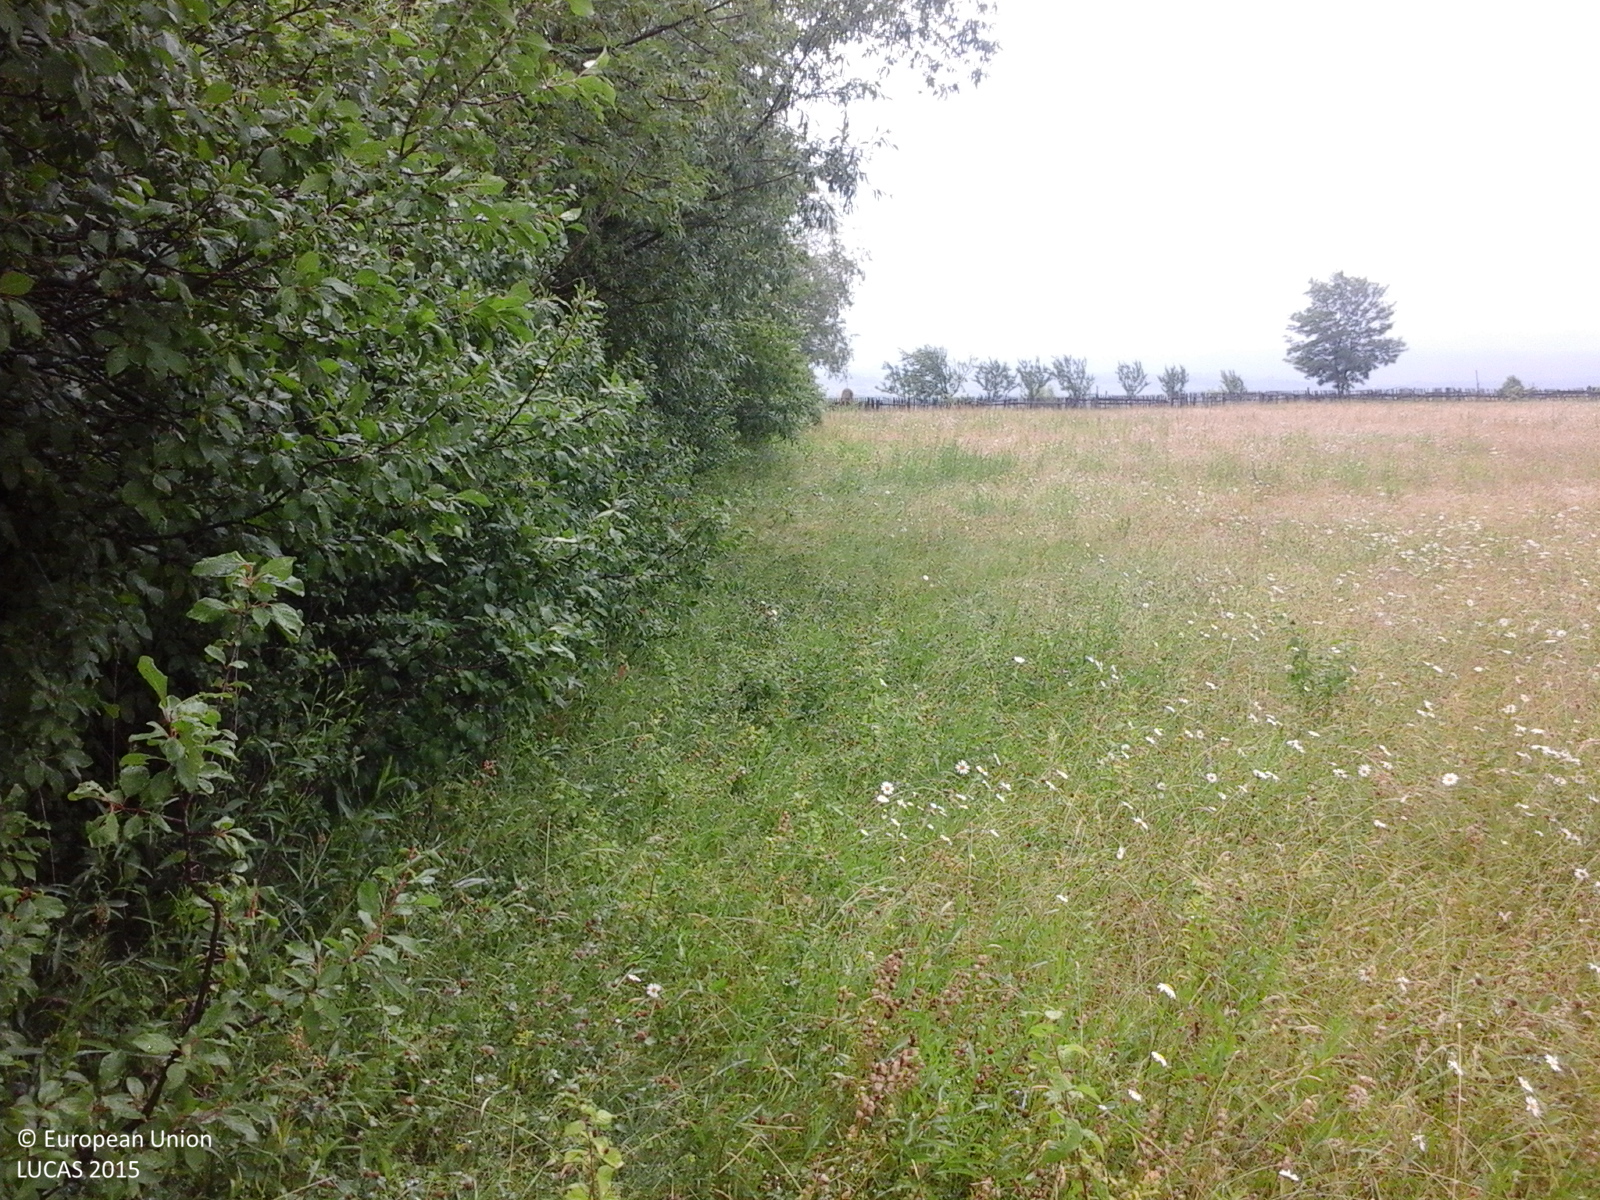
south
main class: Grassland
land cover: Grassland without tree/shrub cover
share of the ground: 50 - 75 %
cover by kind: herbaceous plants 100 %
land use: Agriculture (excluding fallow land and kitchen gardens)
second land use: Forestry
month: June
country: RO
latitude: 47.3525
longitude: 26.2721
